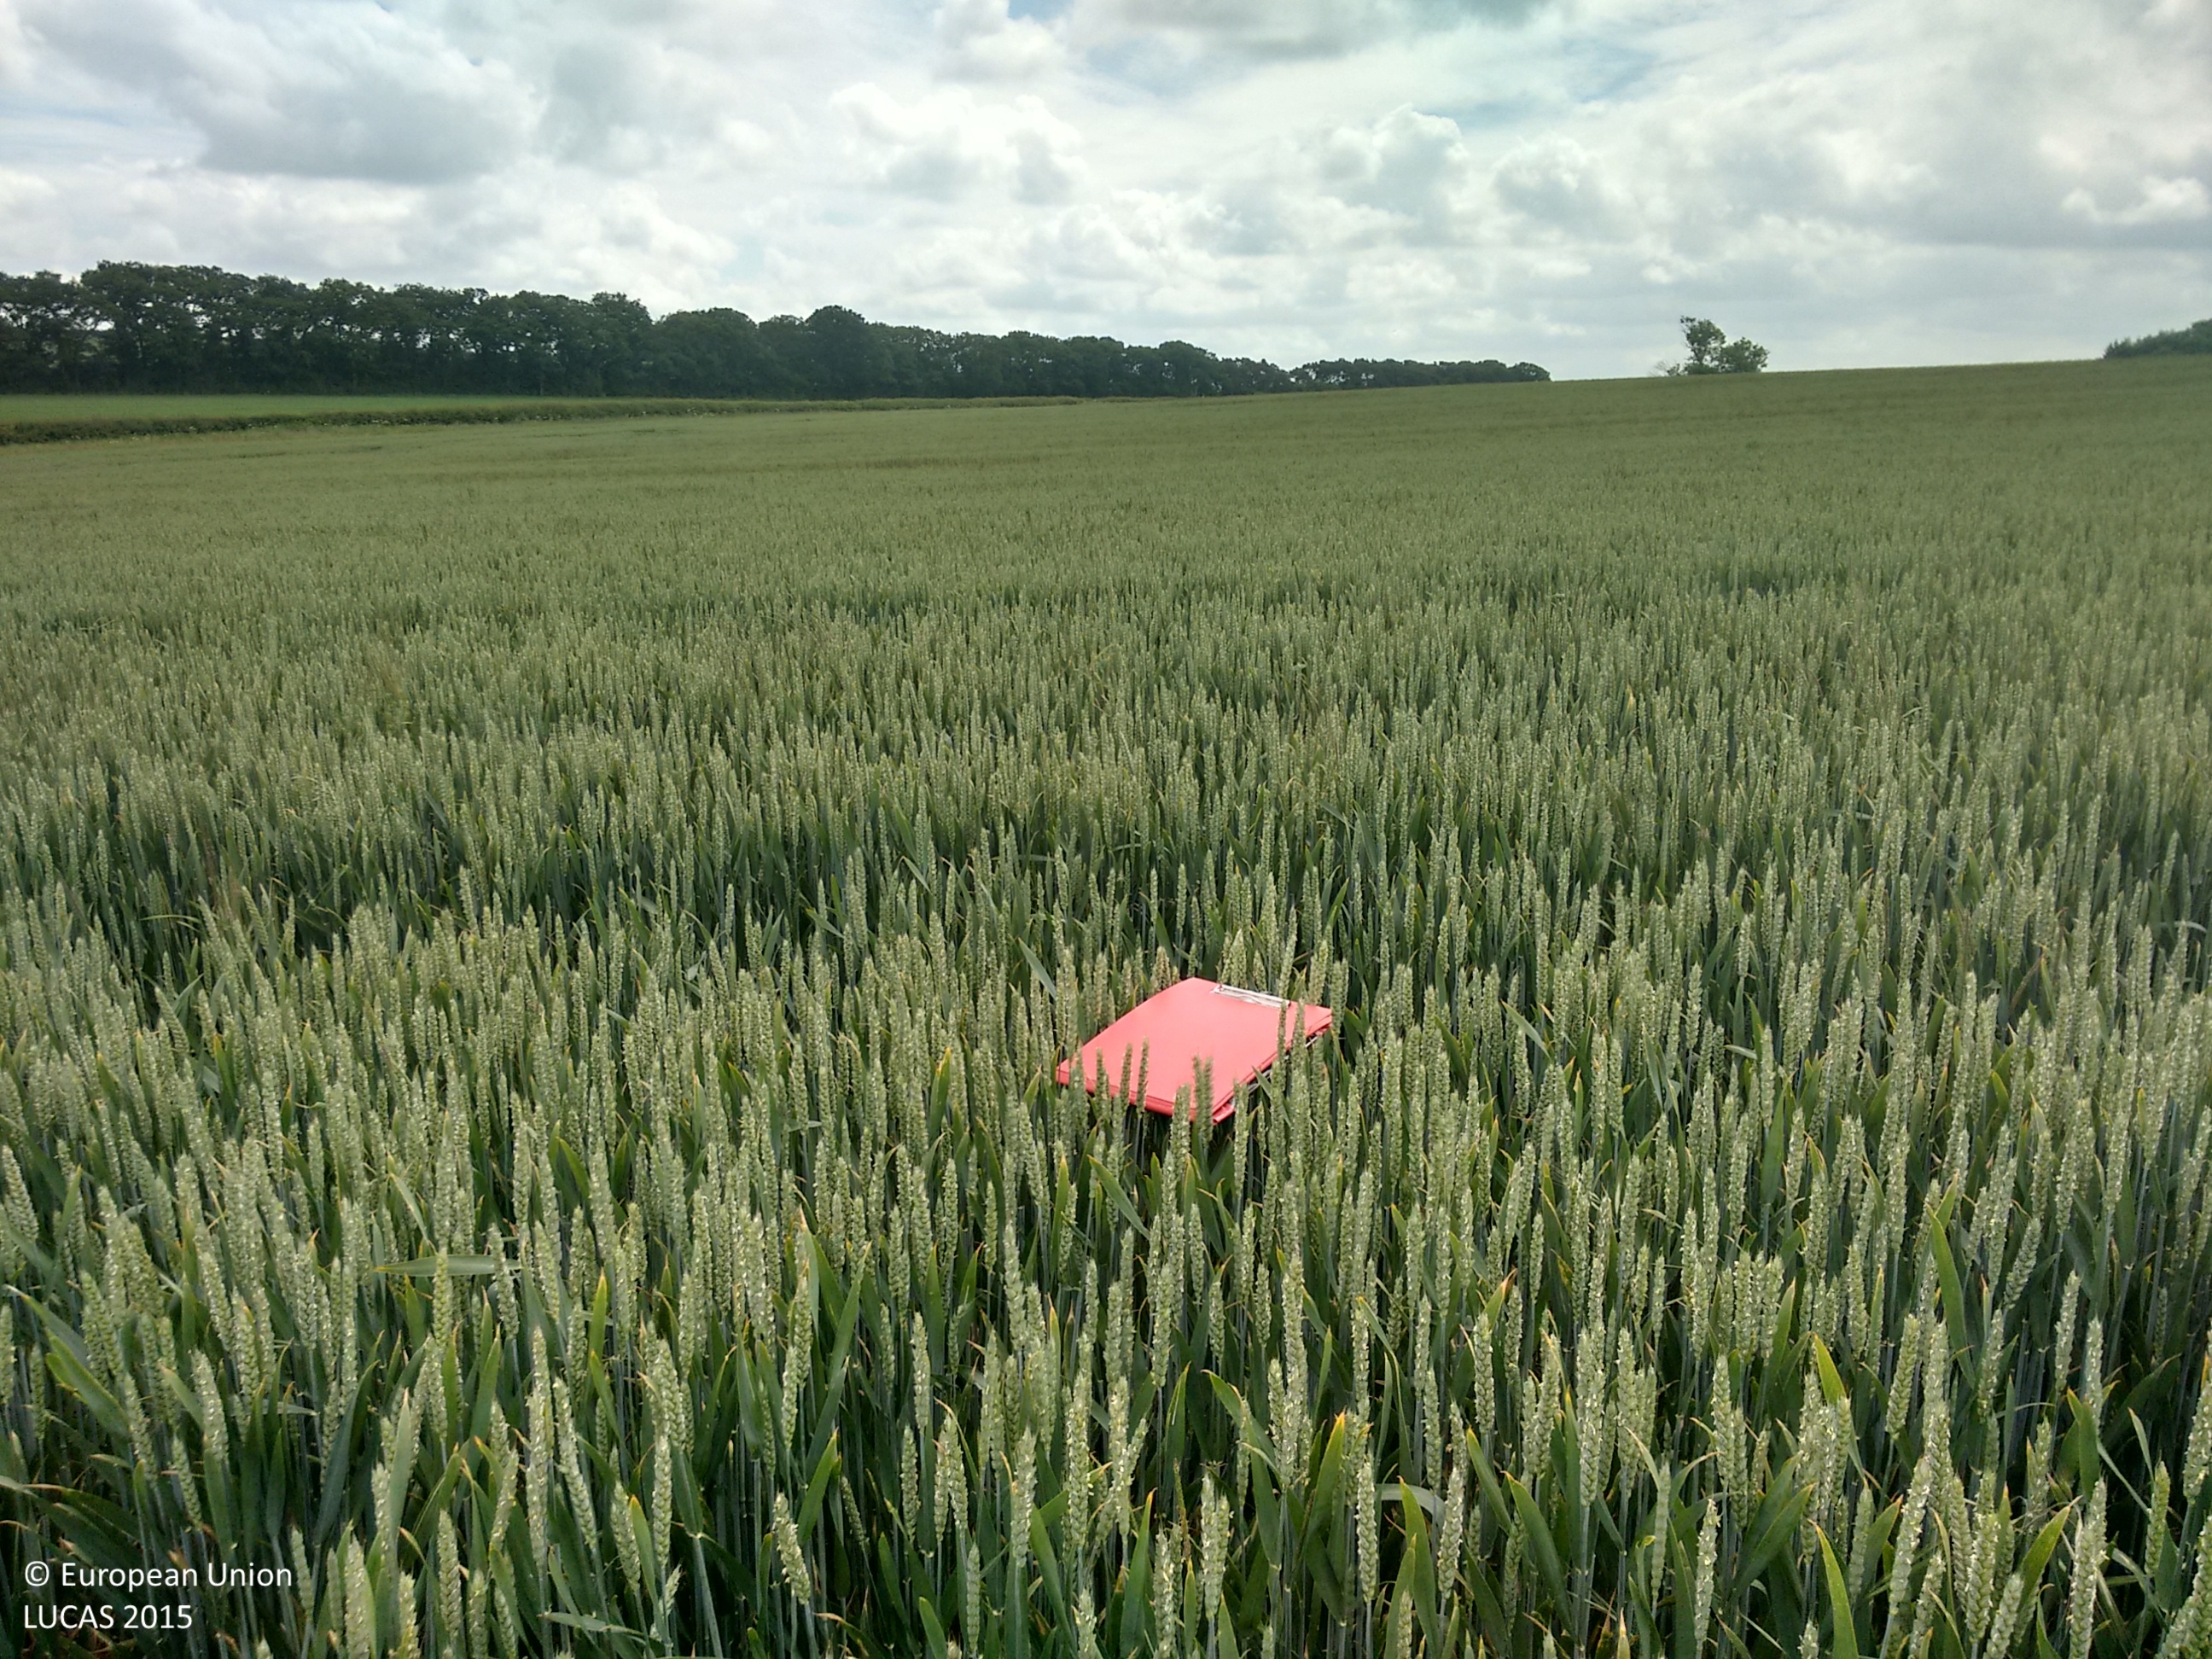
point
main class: Cropland
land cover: Common wheat
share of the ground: > 75 %
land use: Agriculture (excluding fallow land and kitchen gardens)
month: June
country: GB
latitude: 54.2343
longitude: -0.8876
